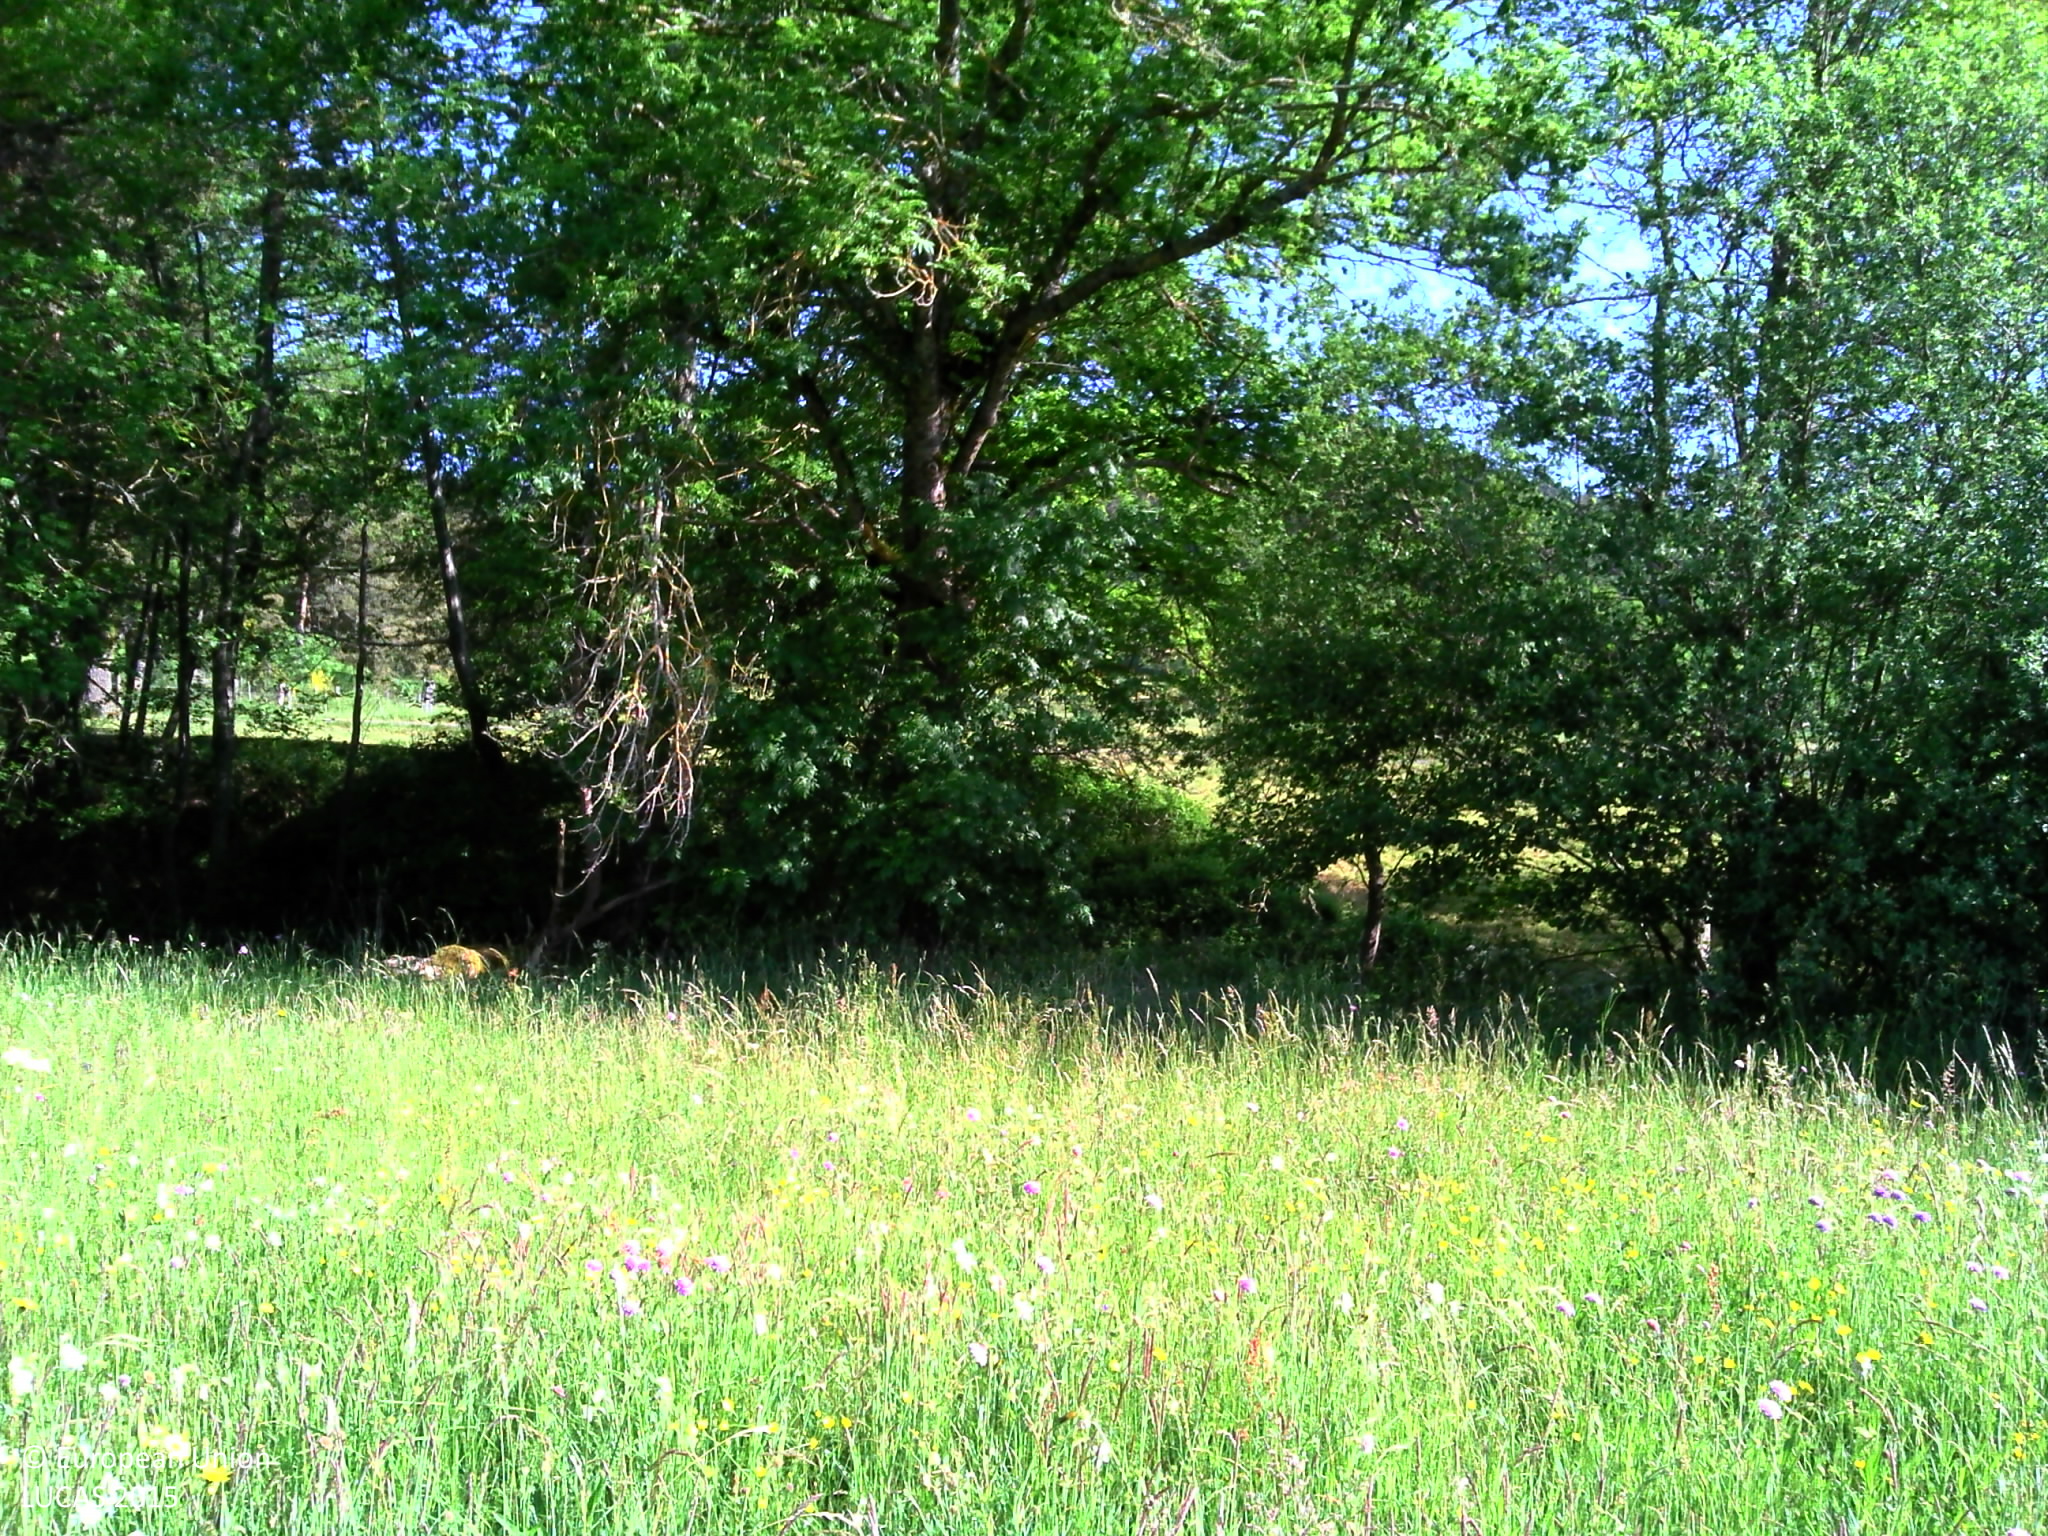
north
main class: Grassland
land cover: Grassland without tree/shrub cover
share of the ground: > 75 %
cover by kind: herbaceous plants 100 %
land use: Agriculture (excluding fallow land and kitchen gardens)
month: June
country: FR
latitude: 44.9625
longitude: 3.2458
